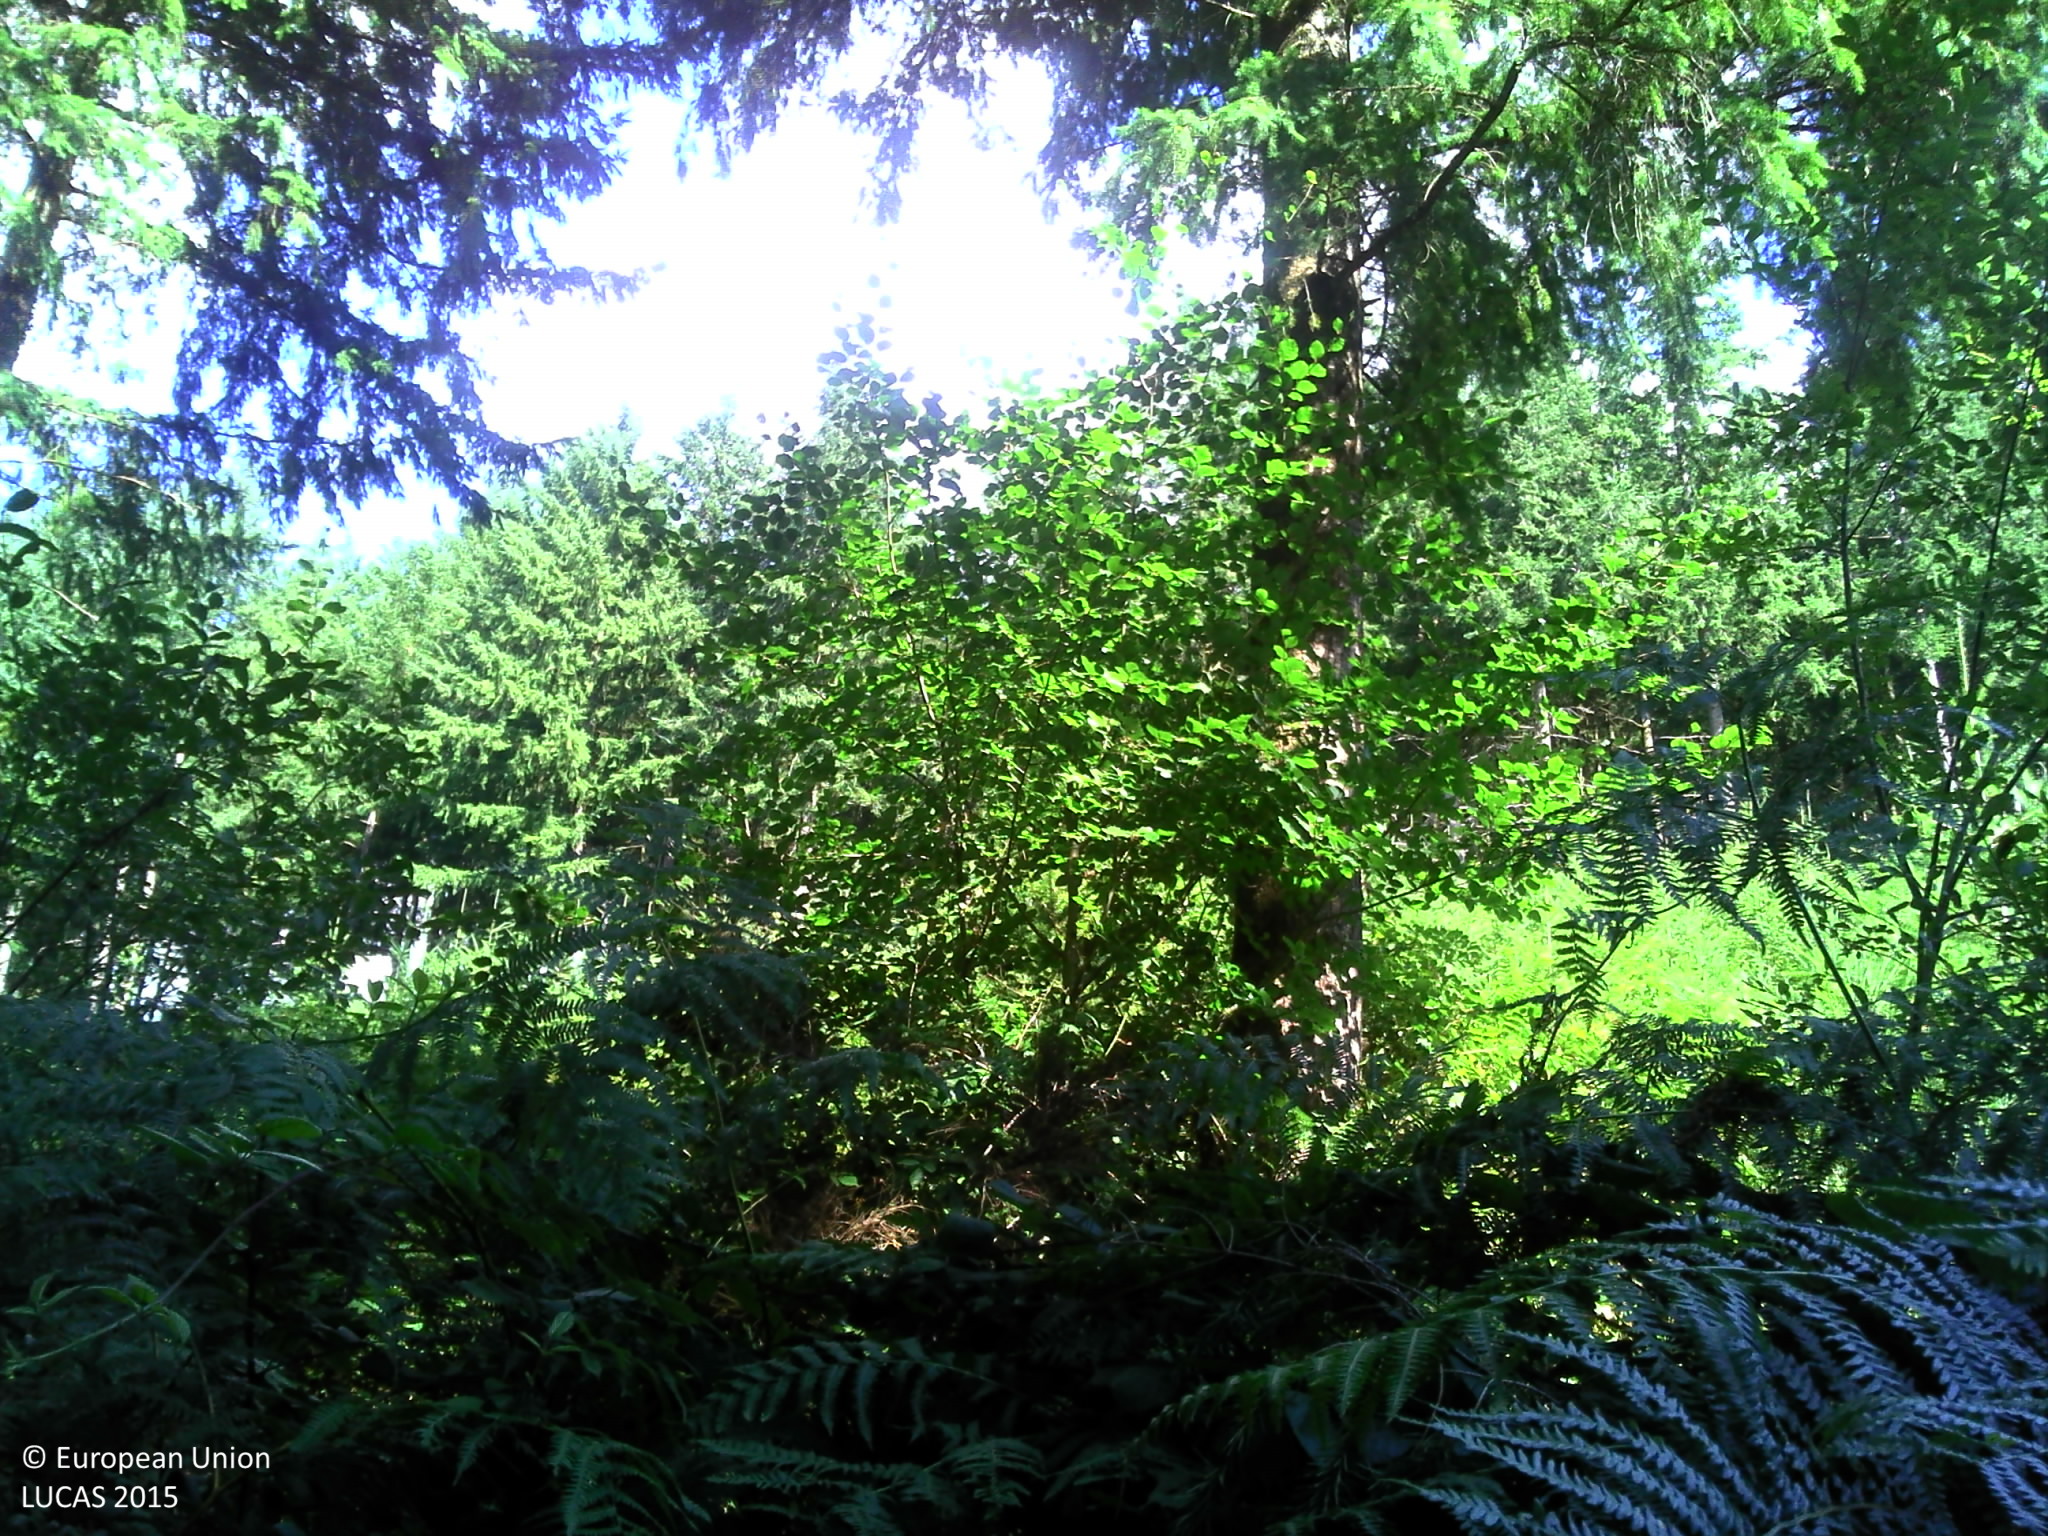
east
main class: Woodland
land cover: Spruce dominated coniferous woodland
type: exotic forest
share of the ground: > 75 %
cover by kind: coniferous forest trees 60 %, shrubs 30 %, broadleaved forest trees 5 %, herbaceous plants 5 %
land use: Forestry
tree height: > 5 m
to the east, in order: Spruce dominated coniferous woodland
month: August
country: FR
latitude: 45.8562
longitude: 1.8157
